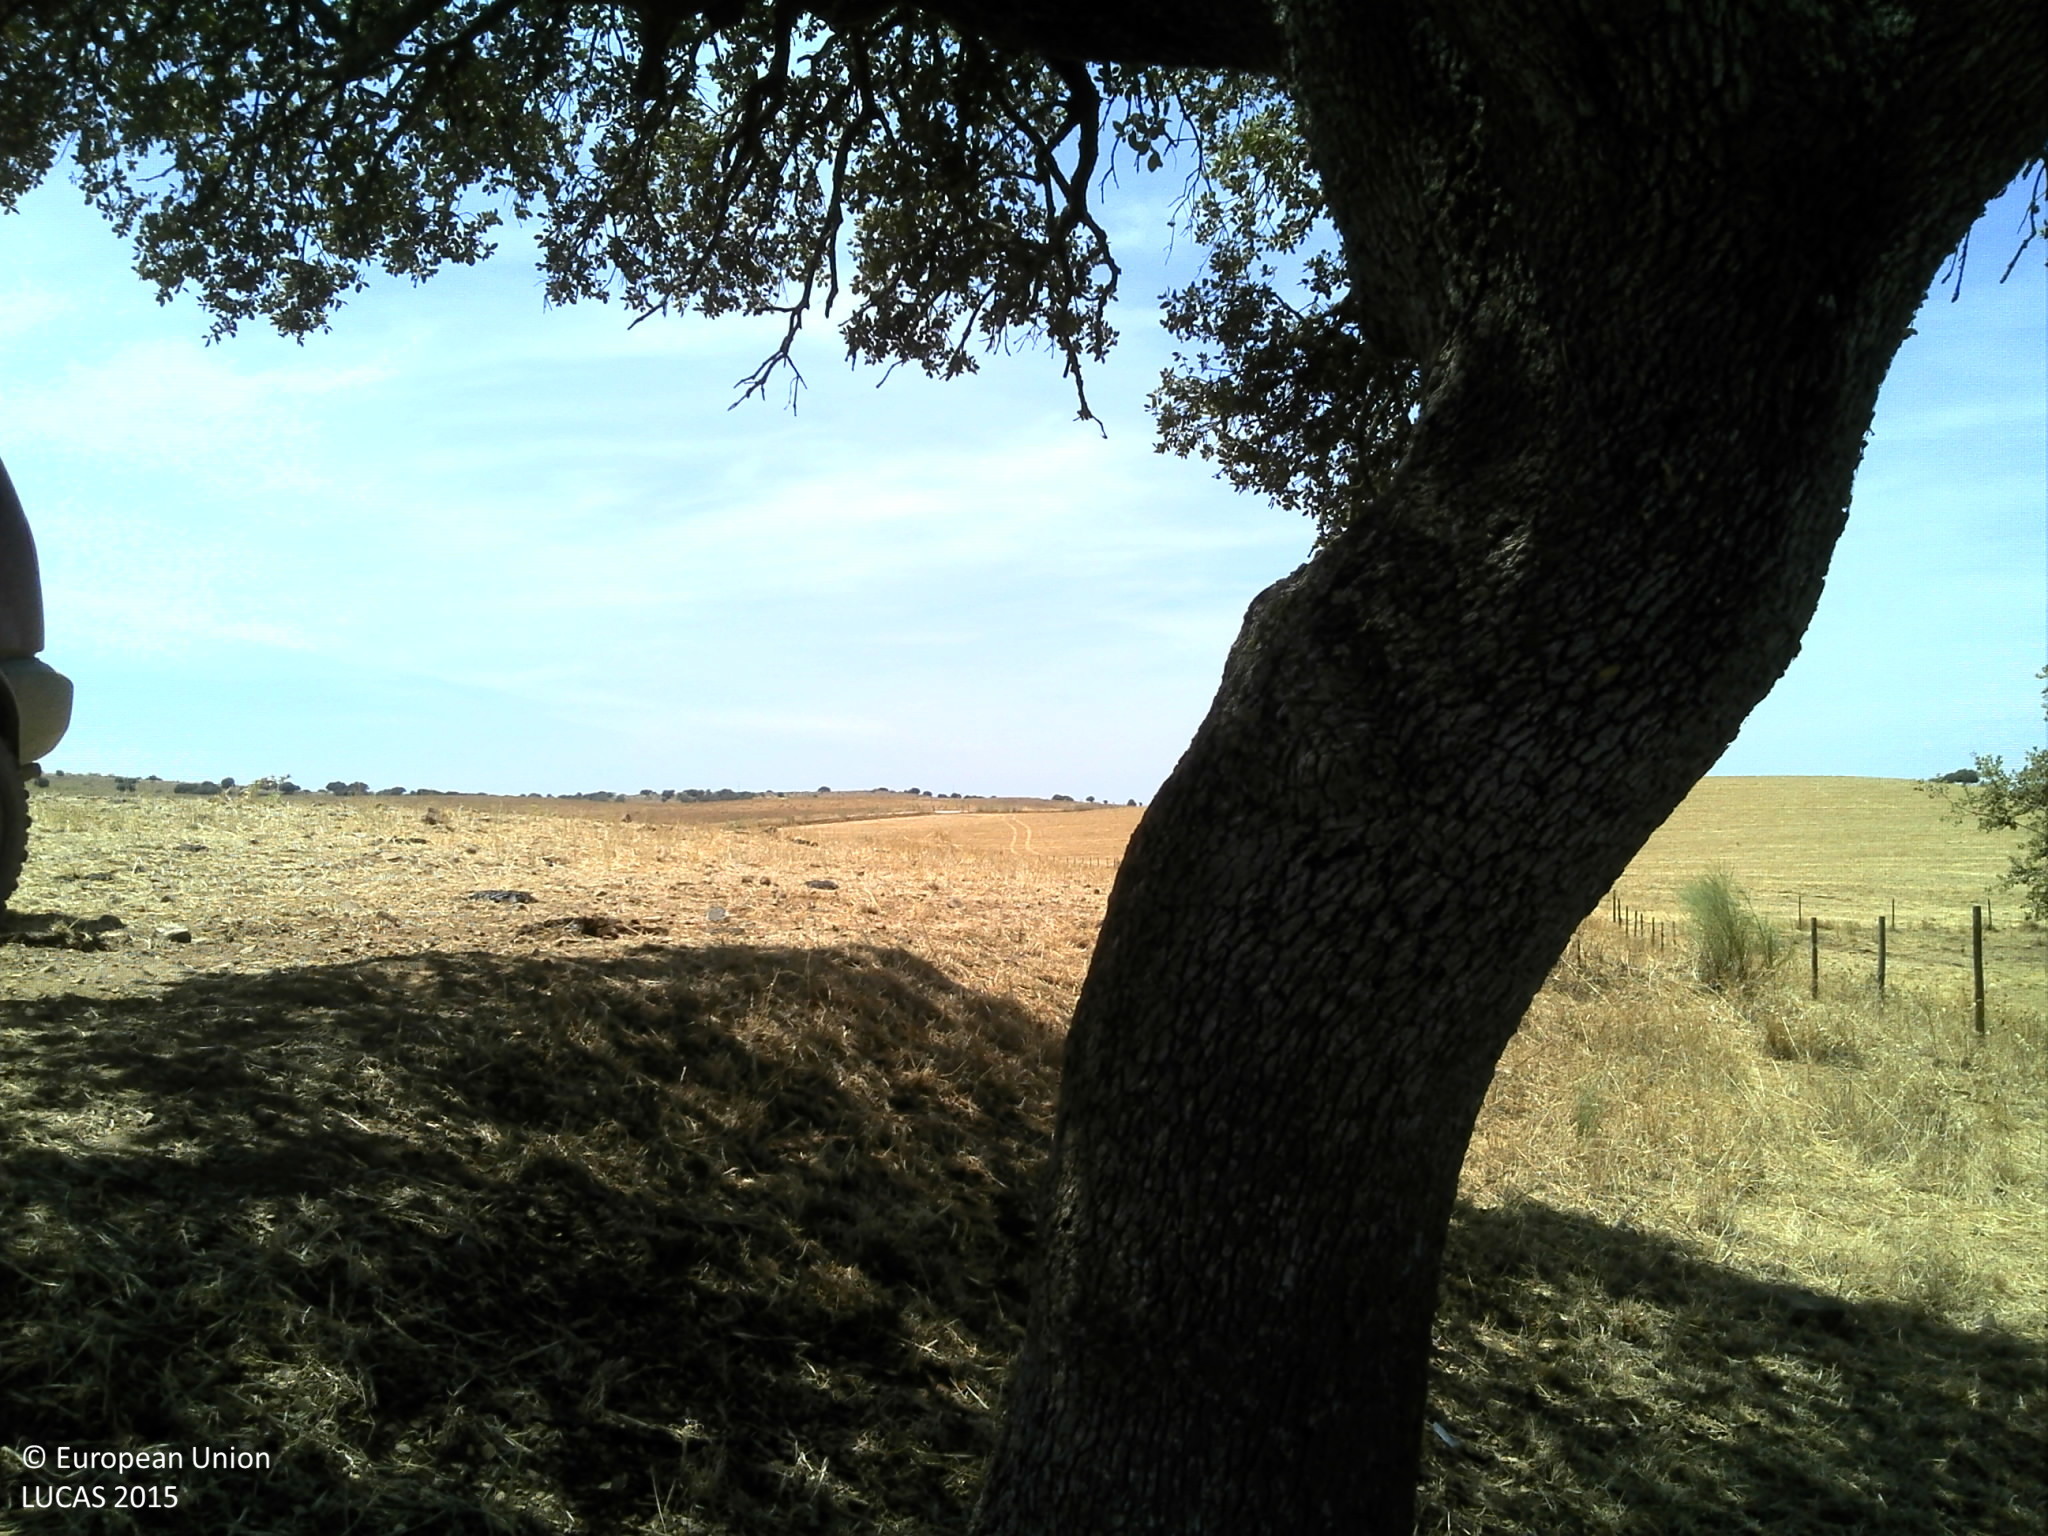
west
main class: Grassland
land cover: Grassland with sparse tree/shrub cover
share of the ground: 10 - 25 %
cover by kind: unconsolidated bare surface 85 %, herbaceous plants 10 %, broadleaved forest trees 5 %
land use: Agriculture (excluding fallow land and kitchen gardens)
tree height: > 5 m
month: July
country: PT
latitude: 38.3960
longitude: -7.4406
